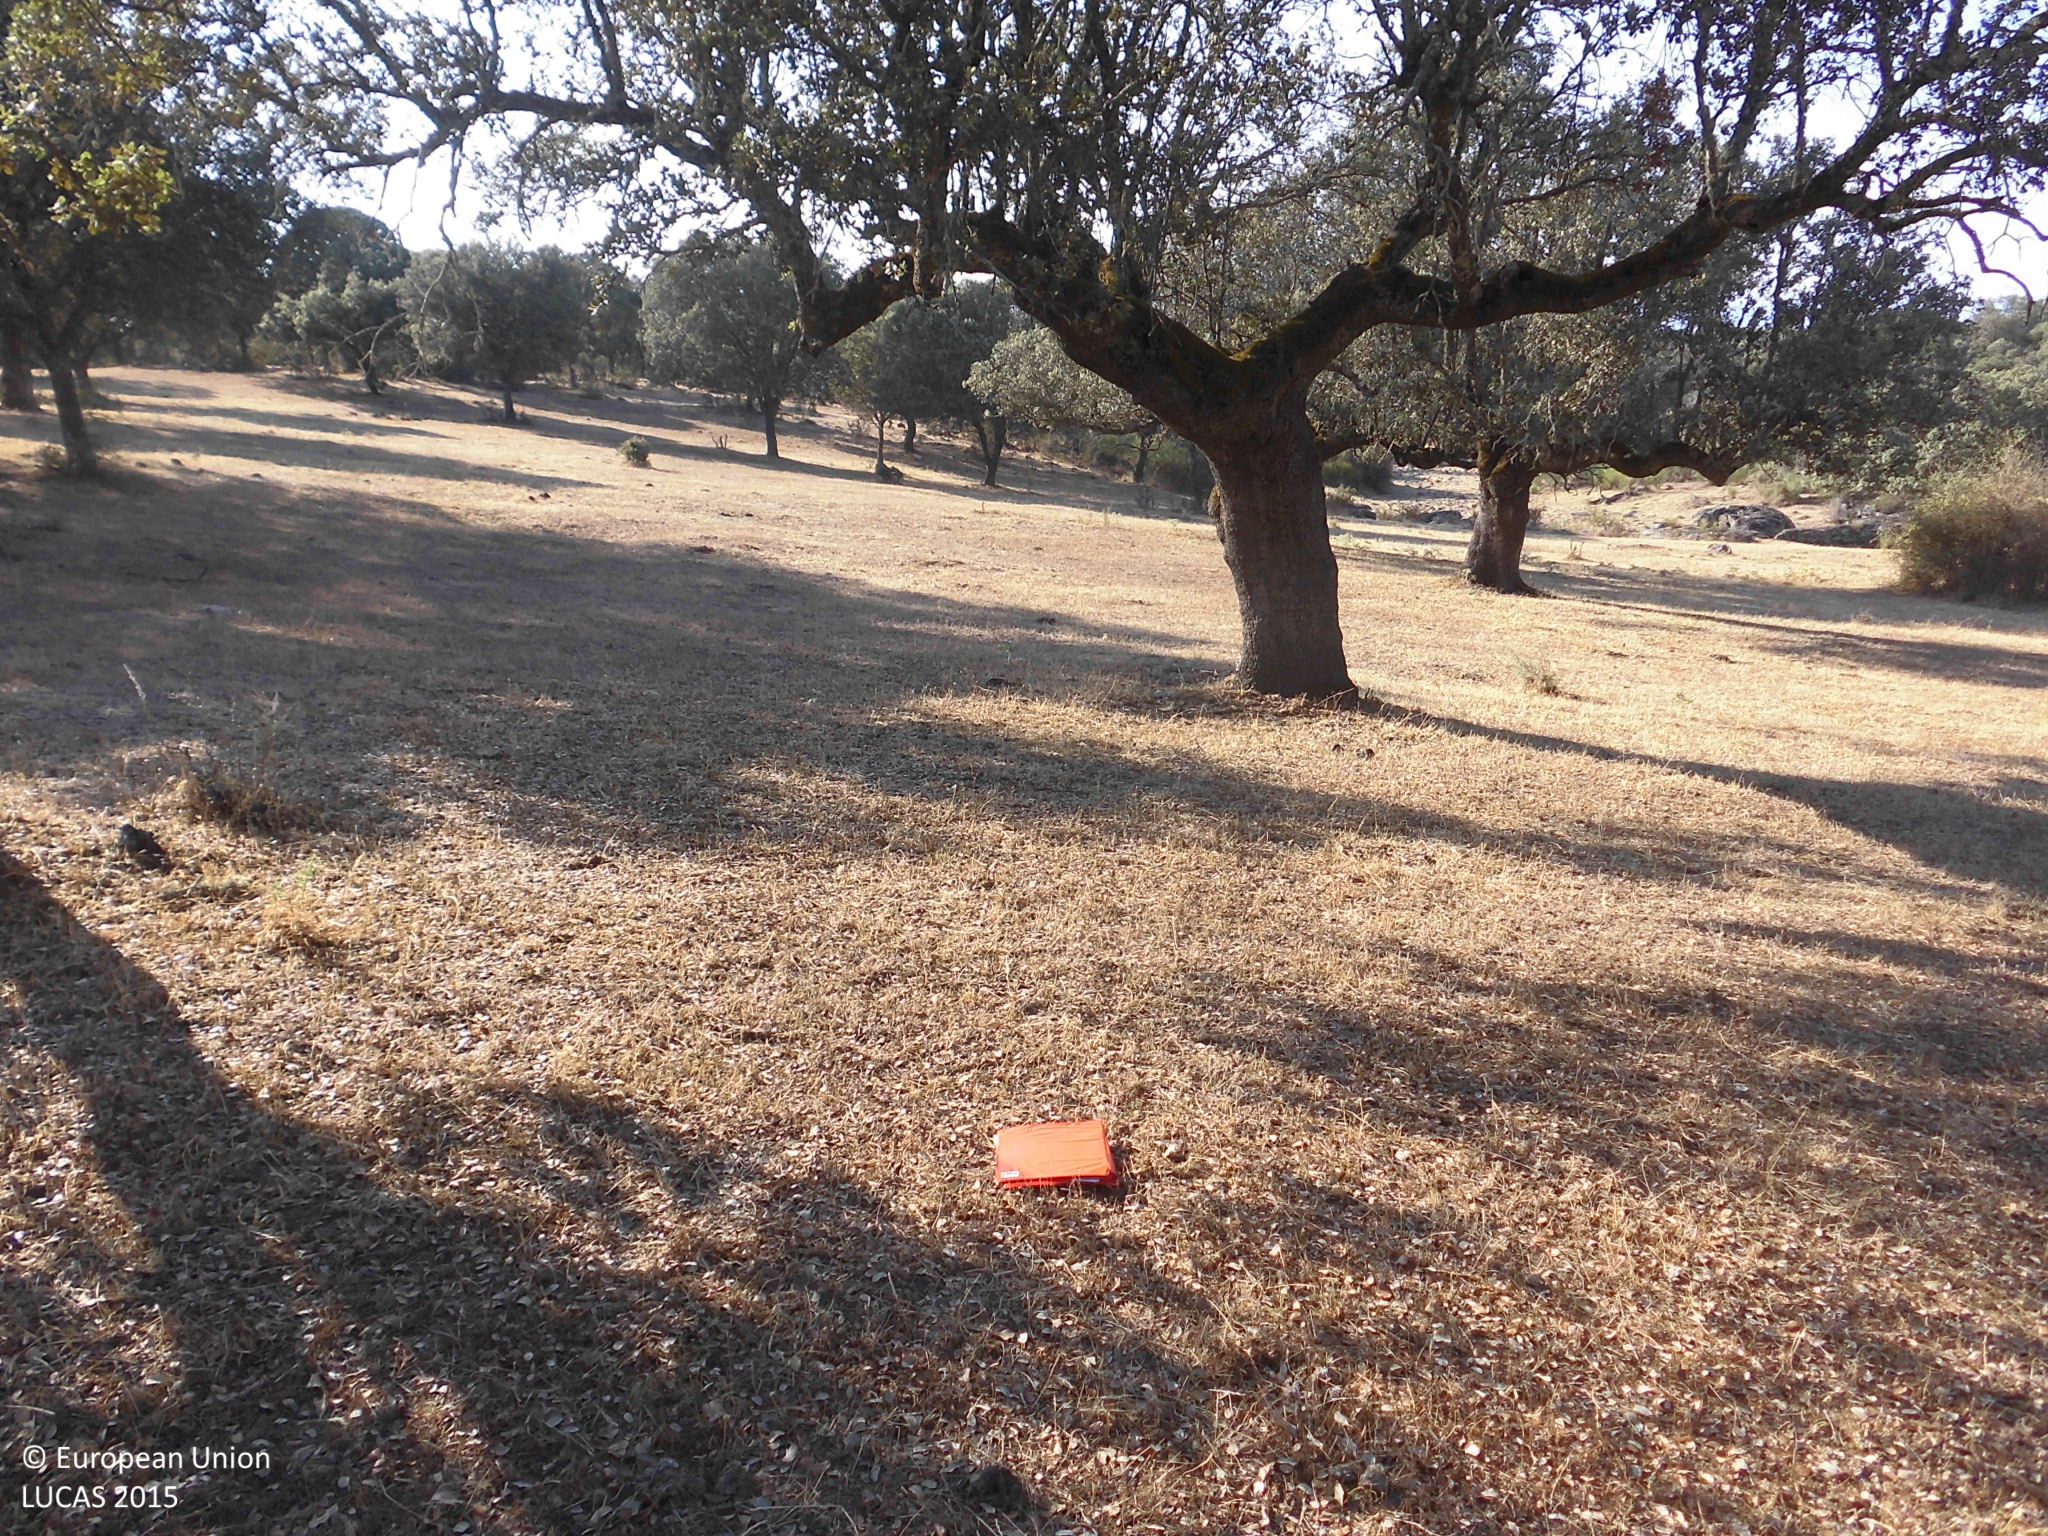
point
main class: Woodland
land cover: Broadleaved woodland
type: broadleaved evergreen forest
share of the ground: 25 - 50 %
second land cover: Grassland without tree/shrub cover
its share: > 75 %
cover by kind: herbaceous plants 70 %, broadleaved forest trees 30 %
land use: Forestry
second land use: Agriculture (excluding fallow land and kitchen gardens)
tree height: > 5 m
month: July
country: ES
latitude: 40.1532
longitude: -6.1460
